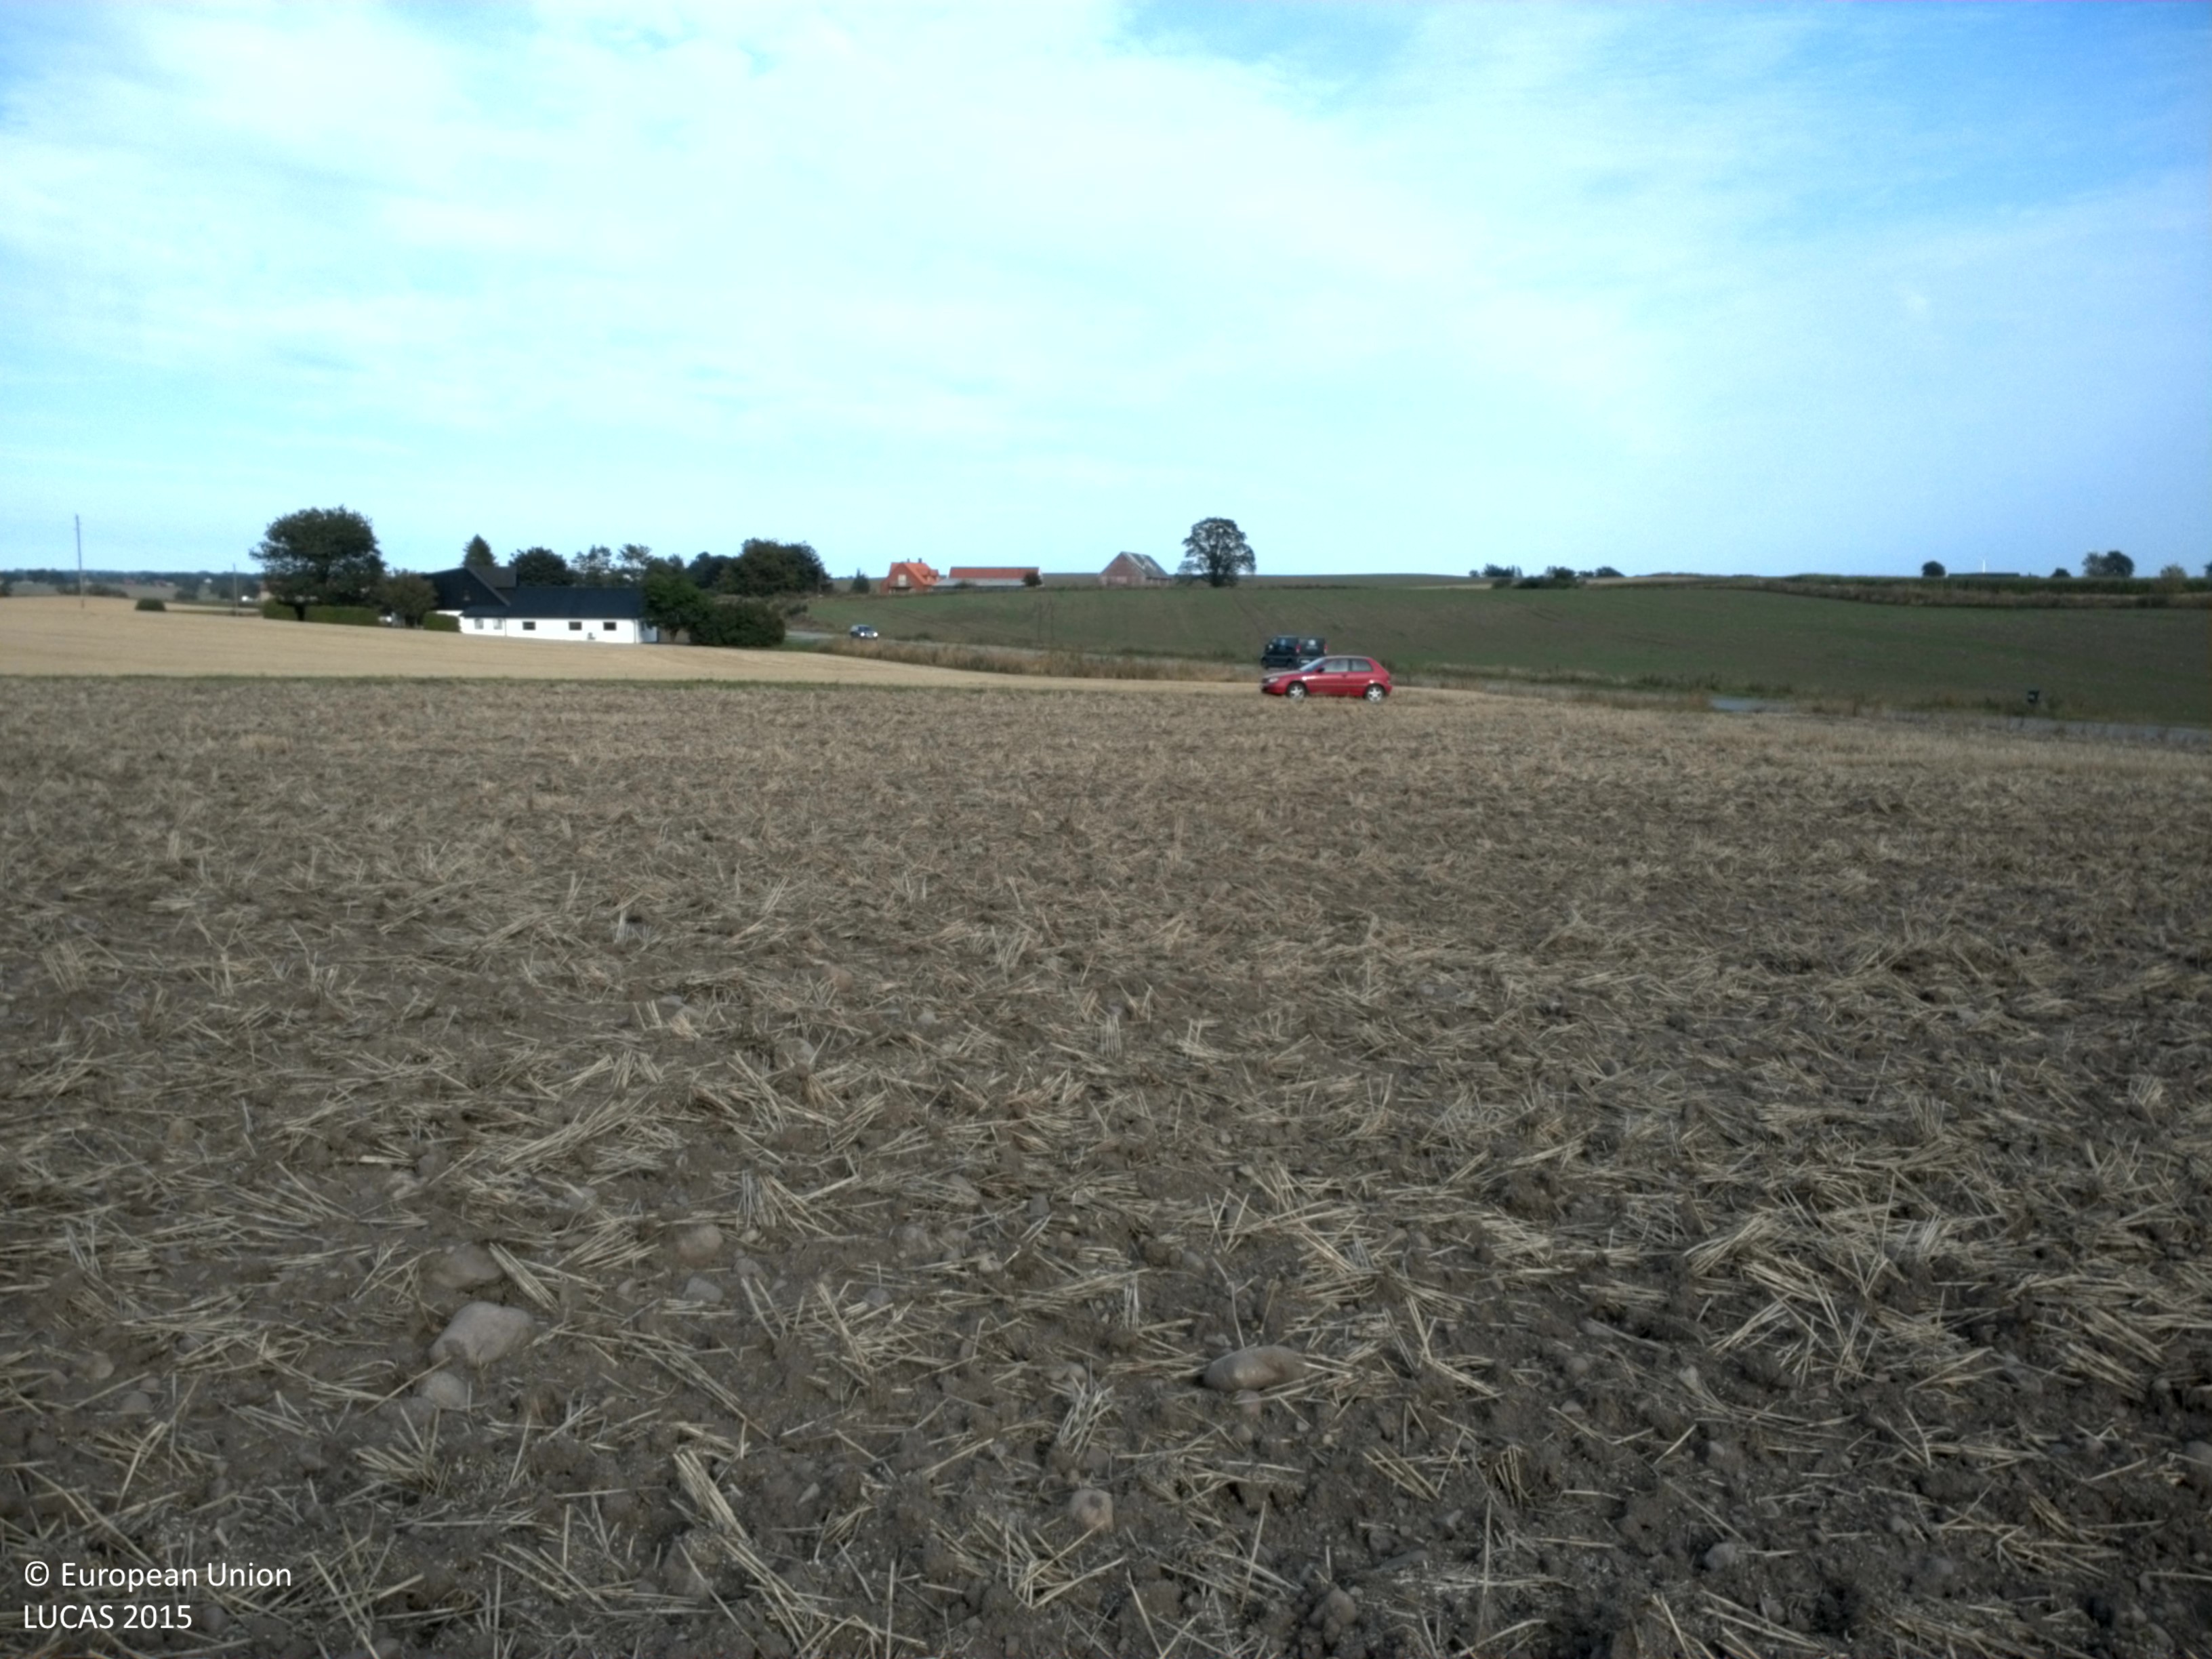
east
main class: Cropland
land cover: Common wheat
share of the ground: < 10 %
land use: Agriculture (excluding fallow land and kitchen gardens)
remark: Harvested field
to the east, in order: Common wheat; Tracks; Grass margins; Barley; Grass margins; Ditches and canals; Paved roads, cycling and walking lanes; Grass margins; Ditches and canals; Rape and turnip rape
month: September
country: SE
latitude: 55.5682
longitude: 13.9788
